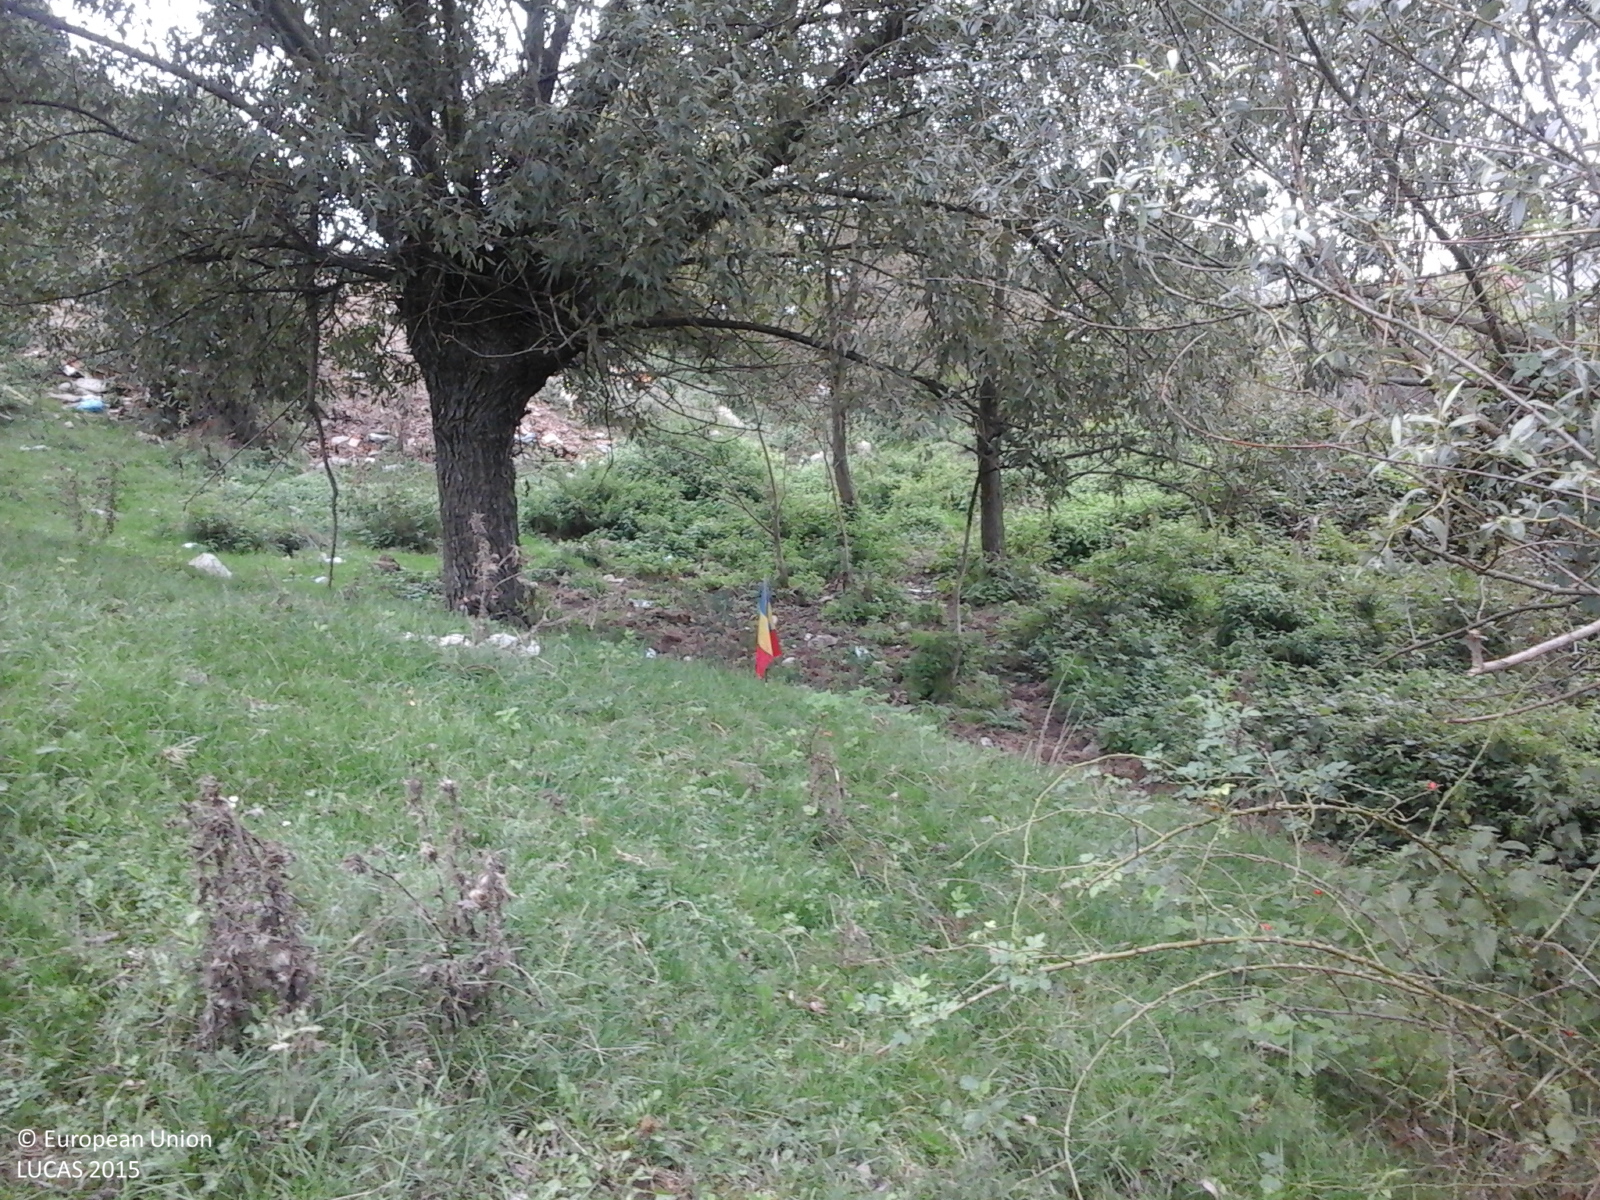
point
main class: Grassland
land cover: Grassland with sparse tree/shrub cover
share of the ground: > 75 %
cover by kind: herbaceous plants 90 %, broadleaved forest trees 5 %, shrubs 5 %
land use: Agriculture (excluding fallow land and kitchen gardens)
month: September
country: RO
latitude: 45.8081
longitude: 23.3010
